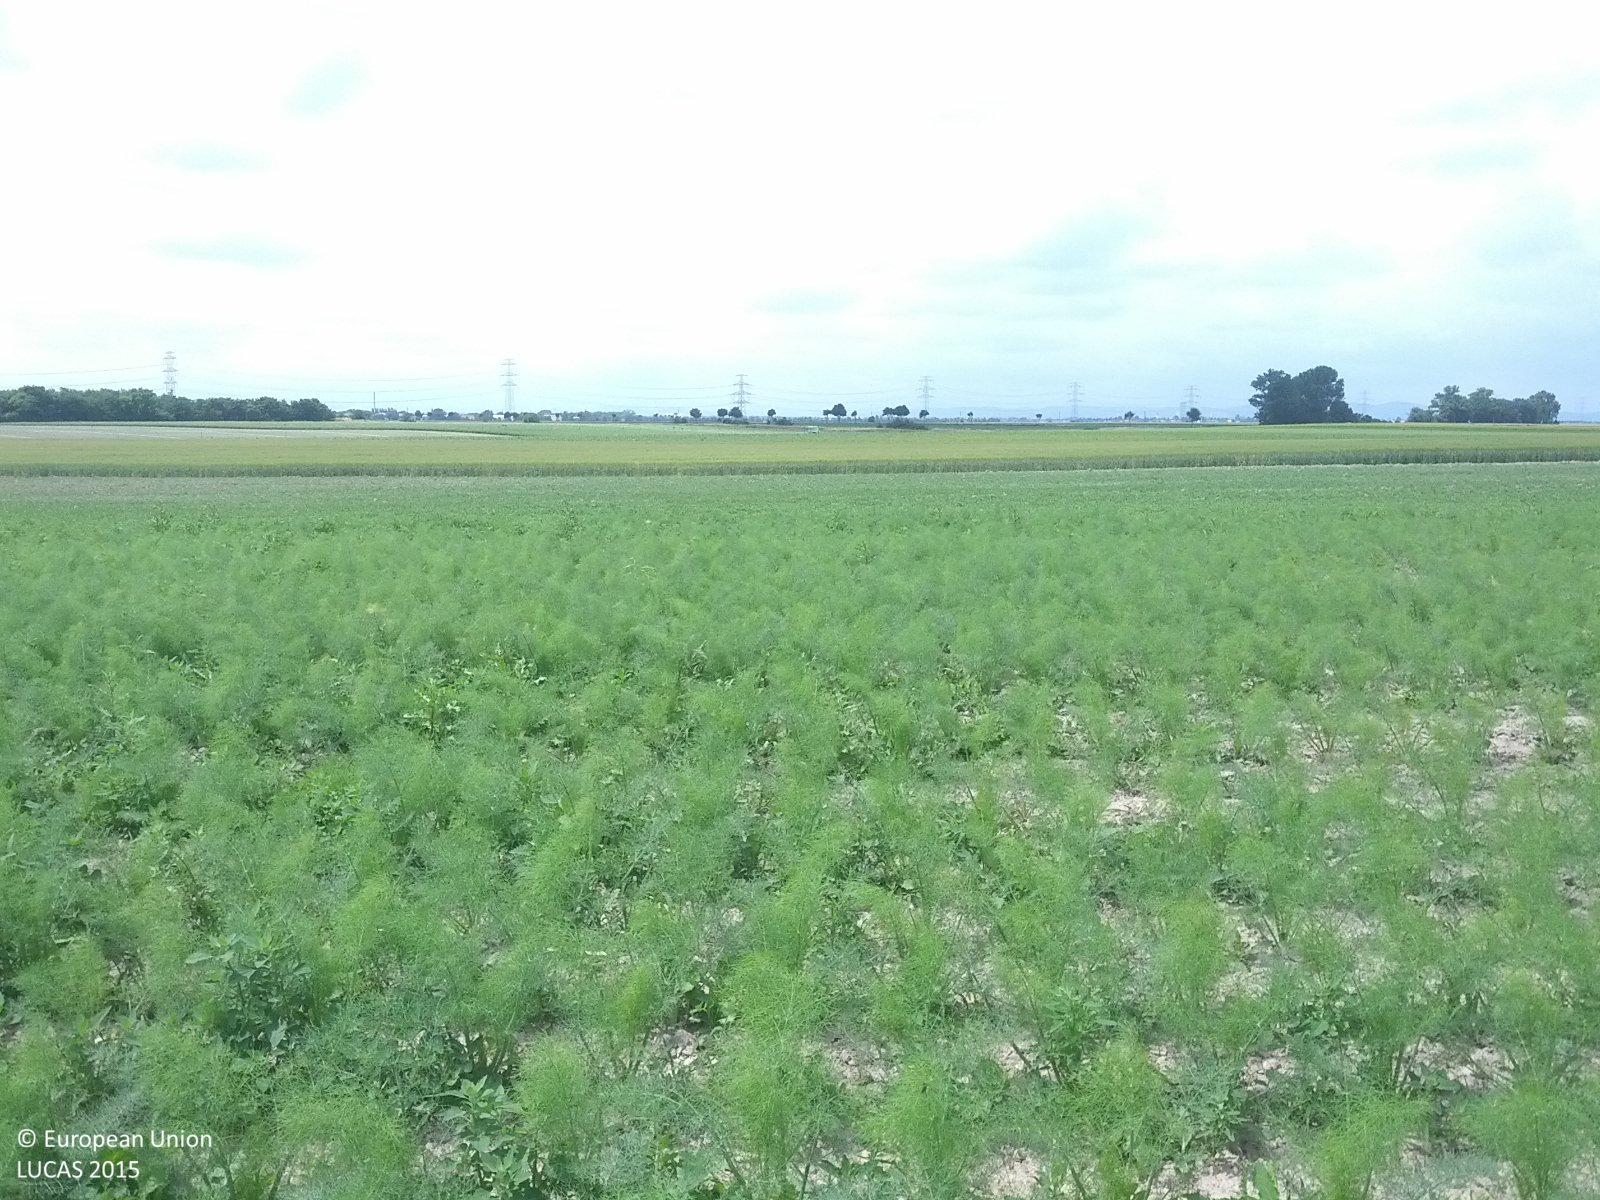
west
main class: Cropland
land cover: Other non-permanent industrial crops
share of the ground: > 75 %
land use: Agriculture (excluding fallow land and kitchen gardens)
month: June
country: AT
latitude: 48.1860
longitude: 16.6373
